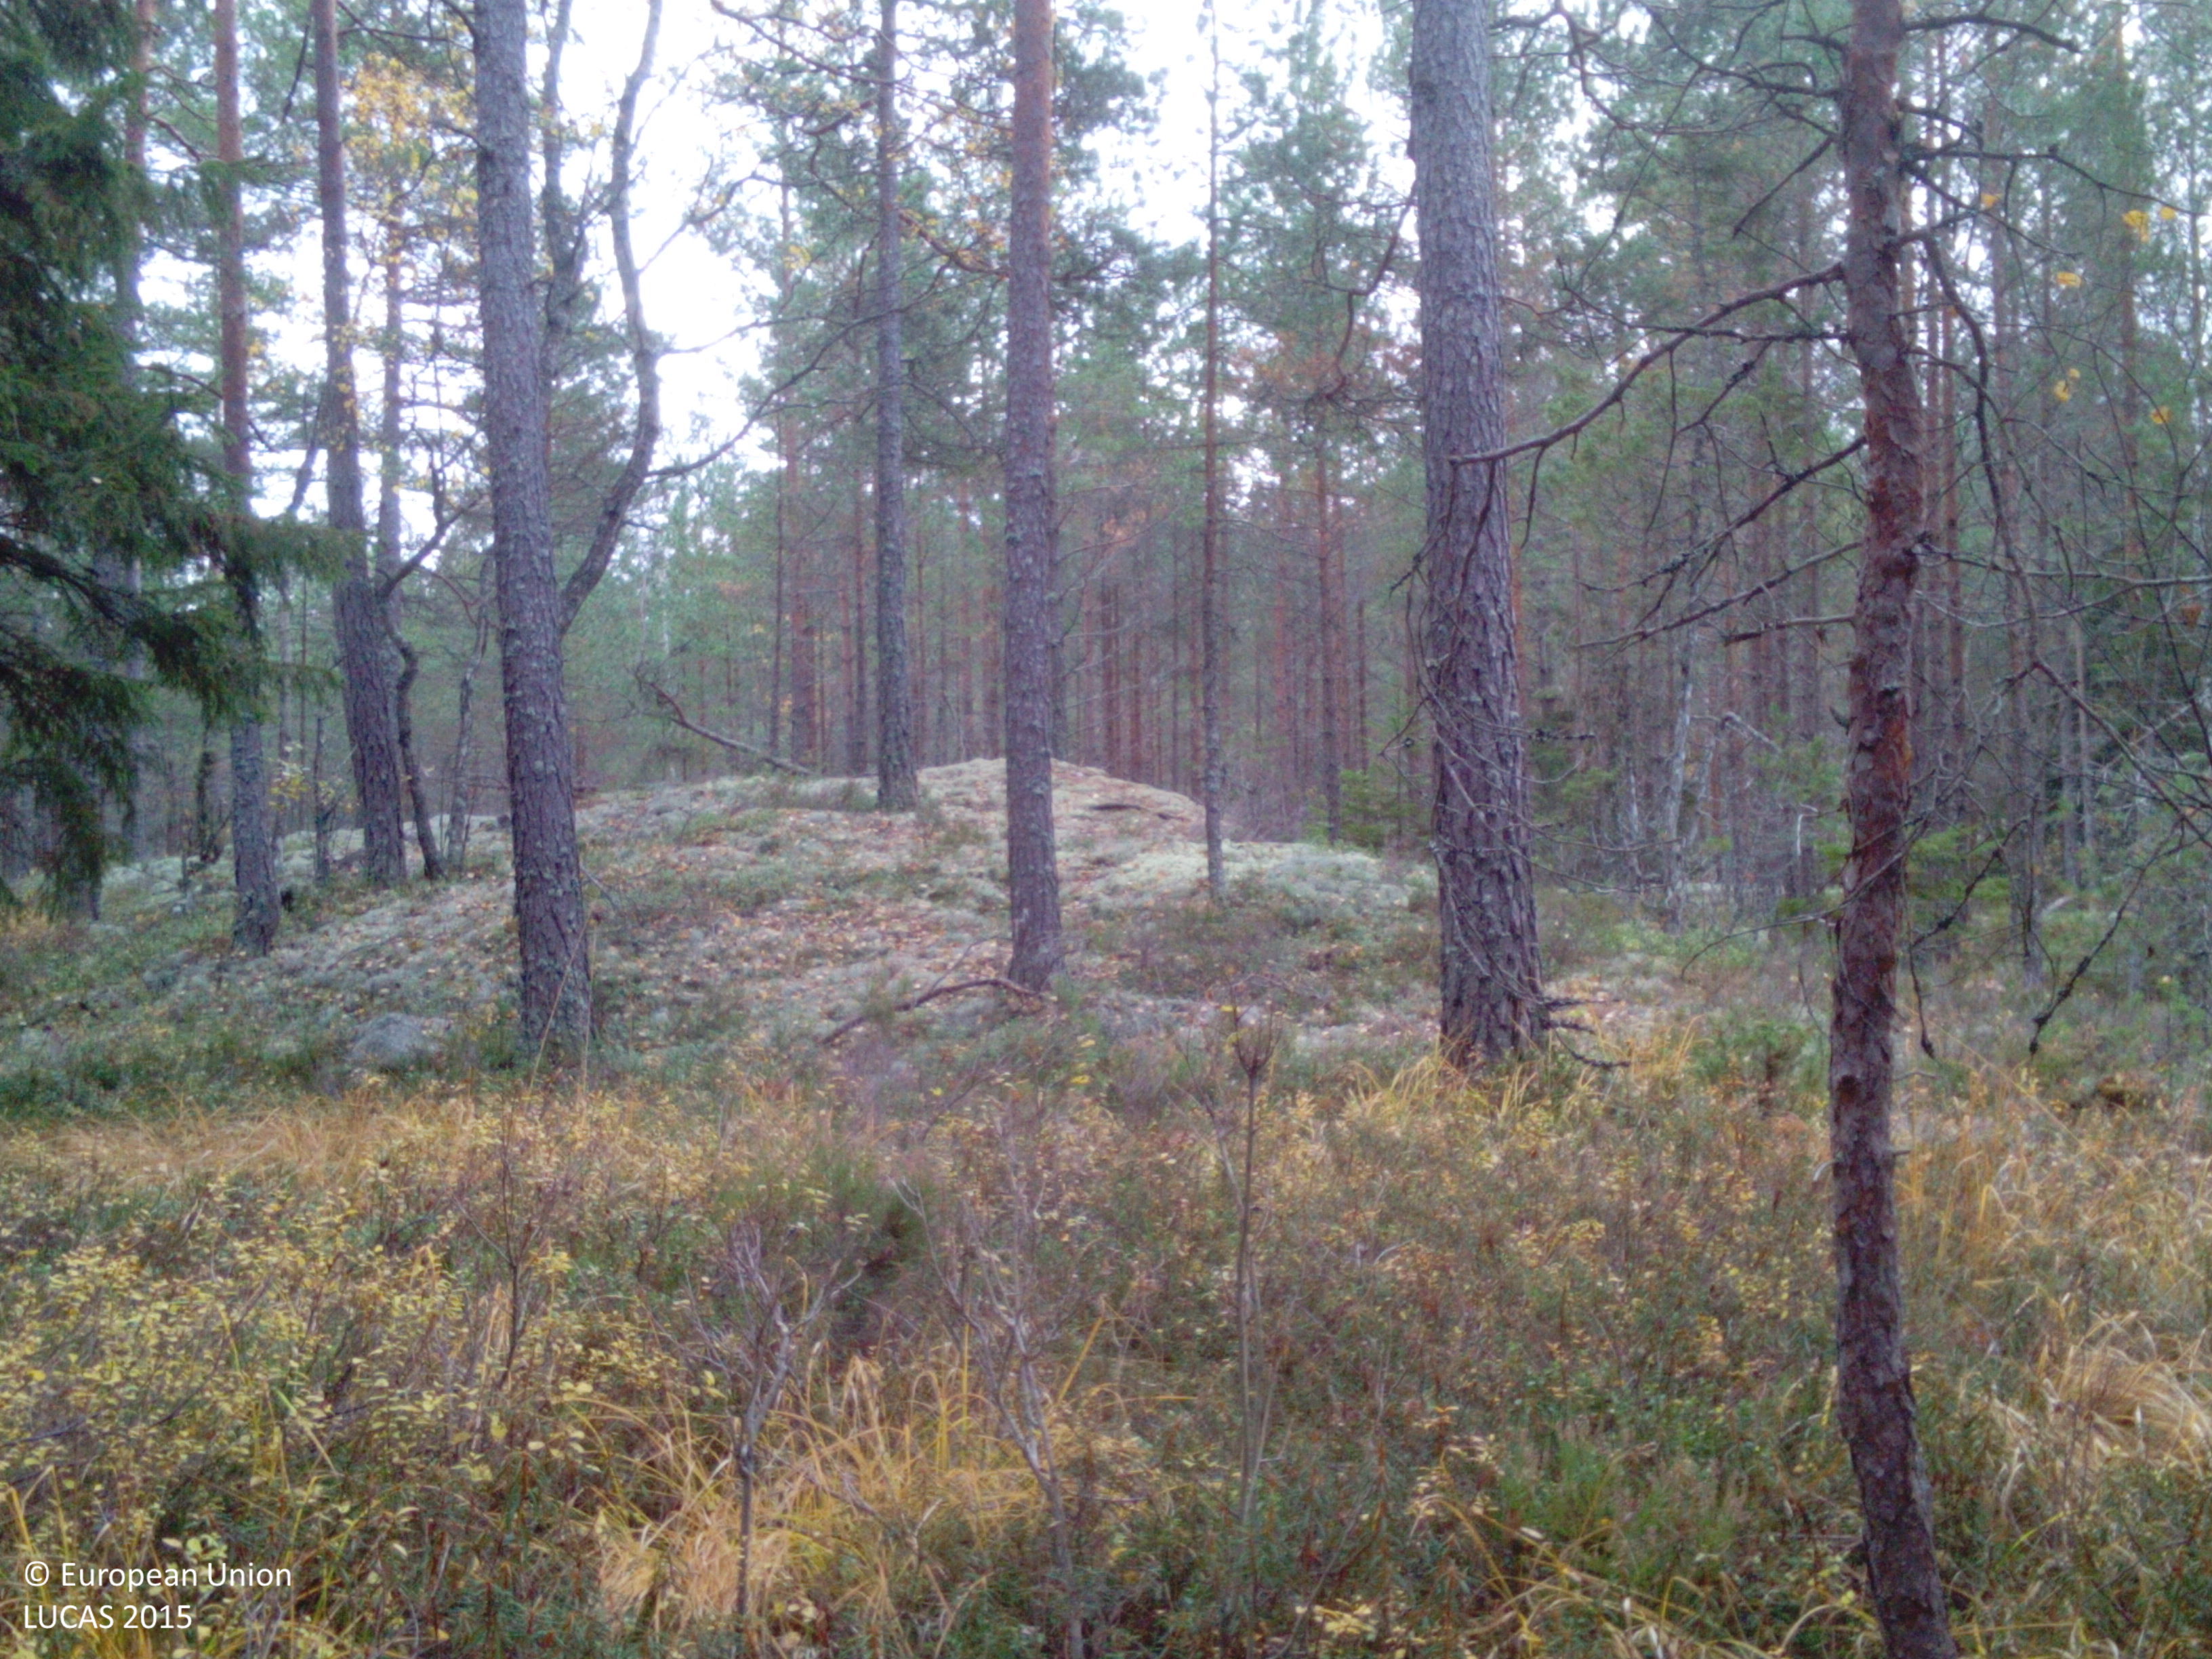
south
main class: Woodland
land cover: Pine dominated coniferous woodland
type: boreal forest
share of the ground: > 75 %
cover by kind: coniferous forest trees 75 %, broadleaved forest trees 10 %, herbaceous plants 10 %, lichens and mosses 5 %
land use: Forestry
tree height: > 5 m
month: October
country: SE
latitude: 59.2166
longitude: 16.5277
